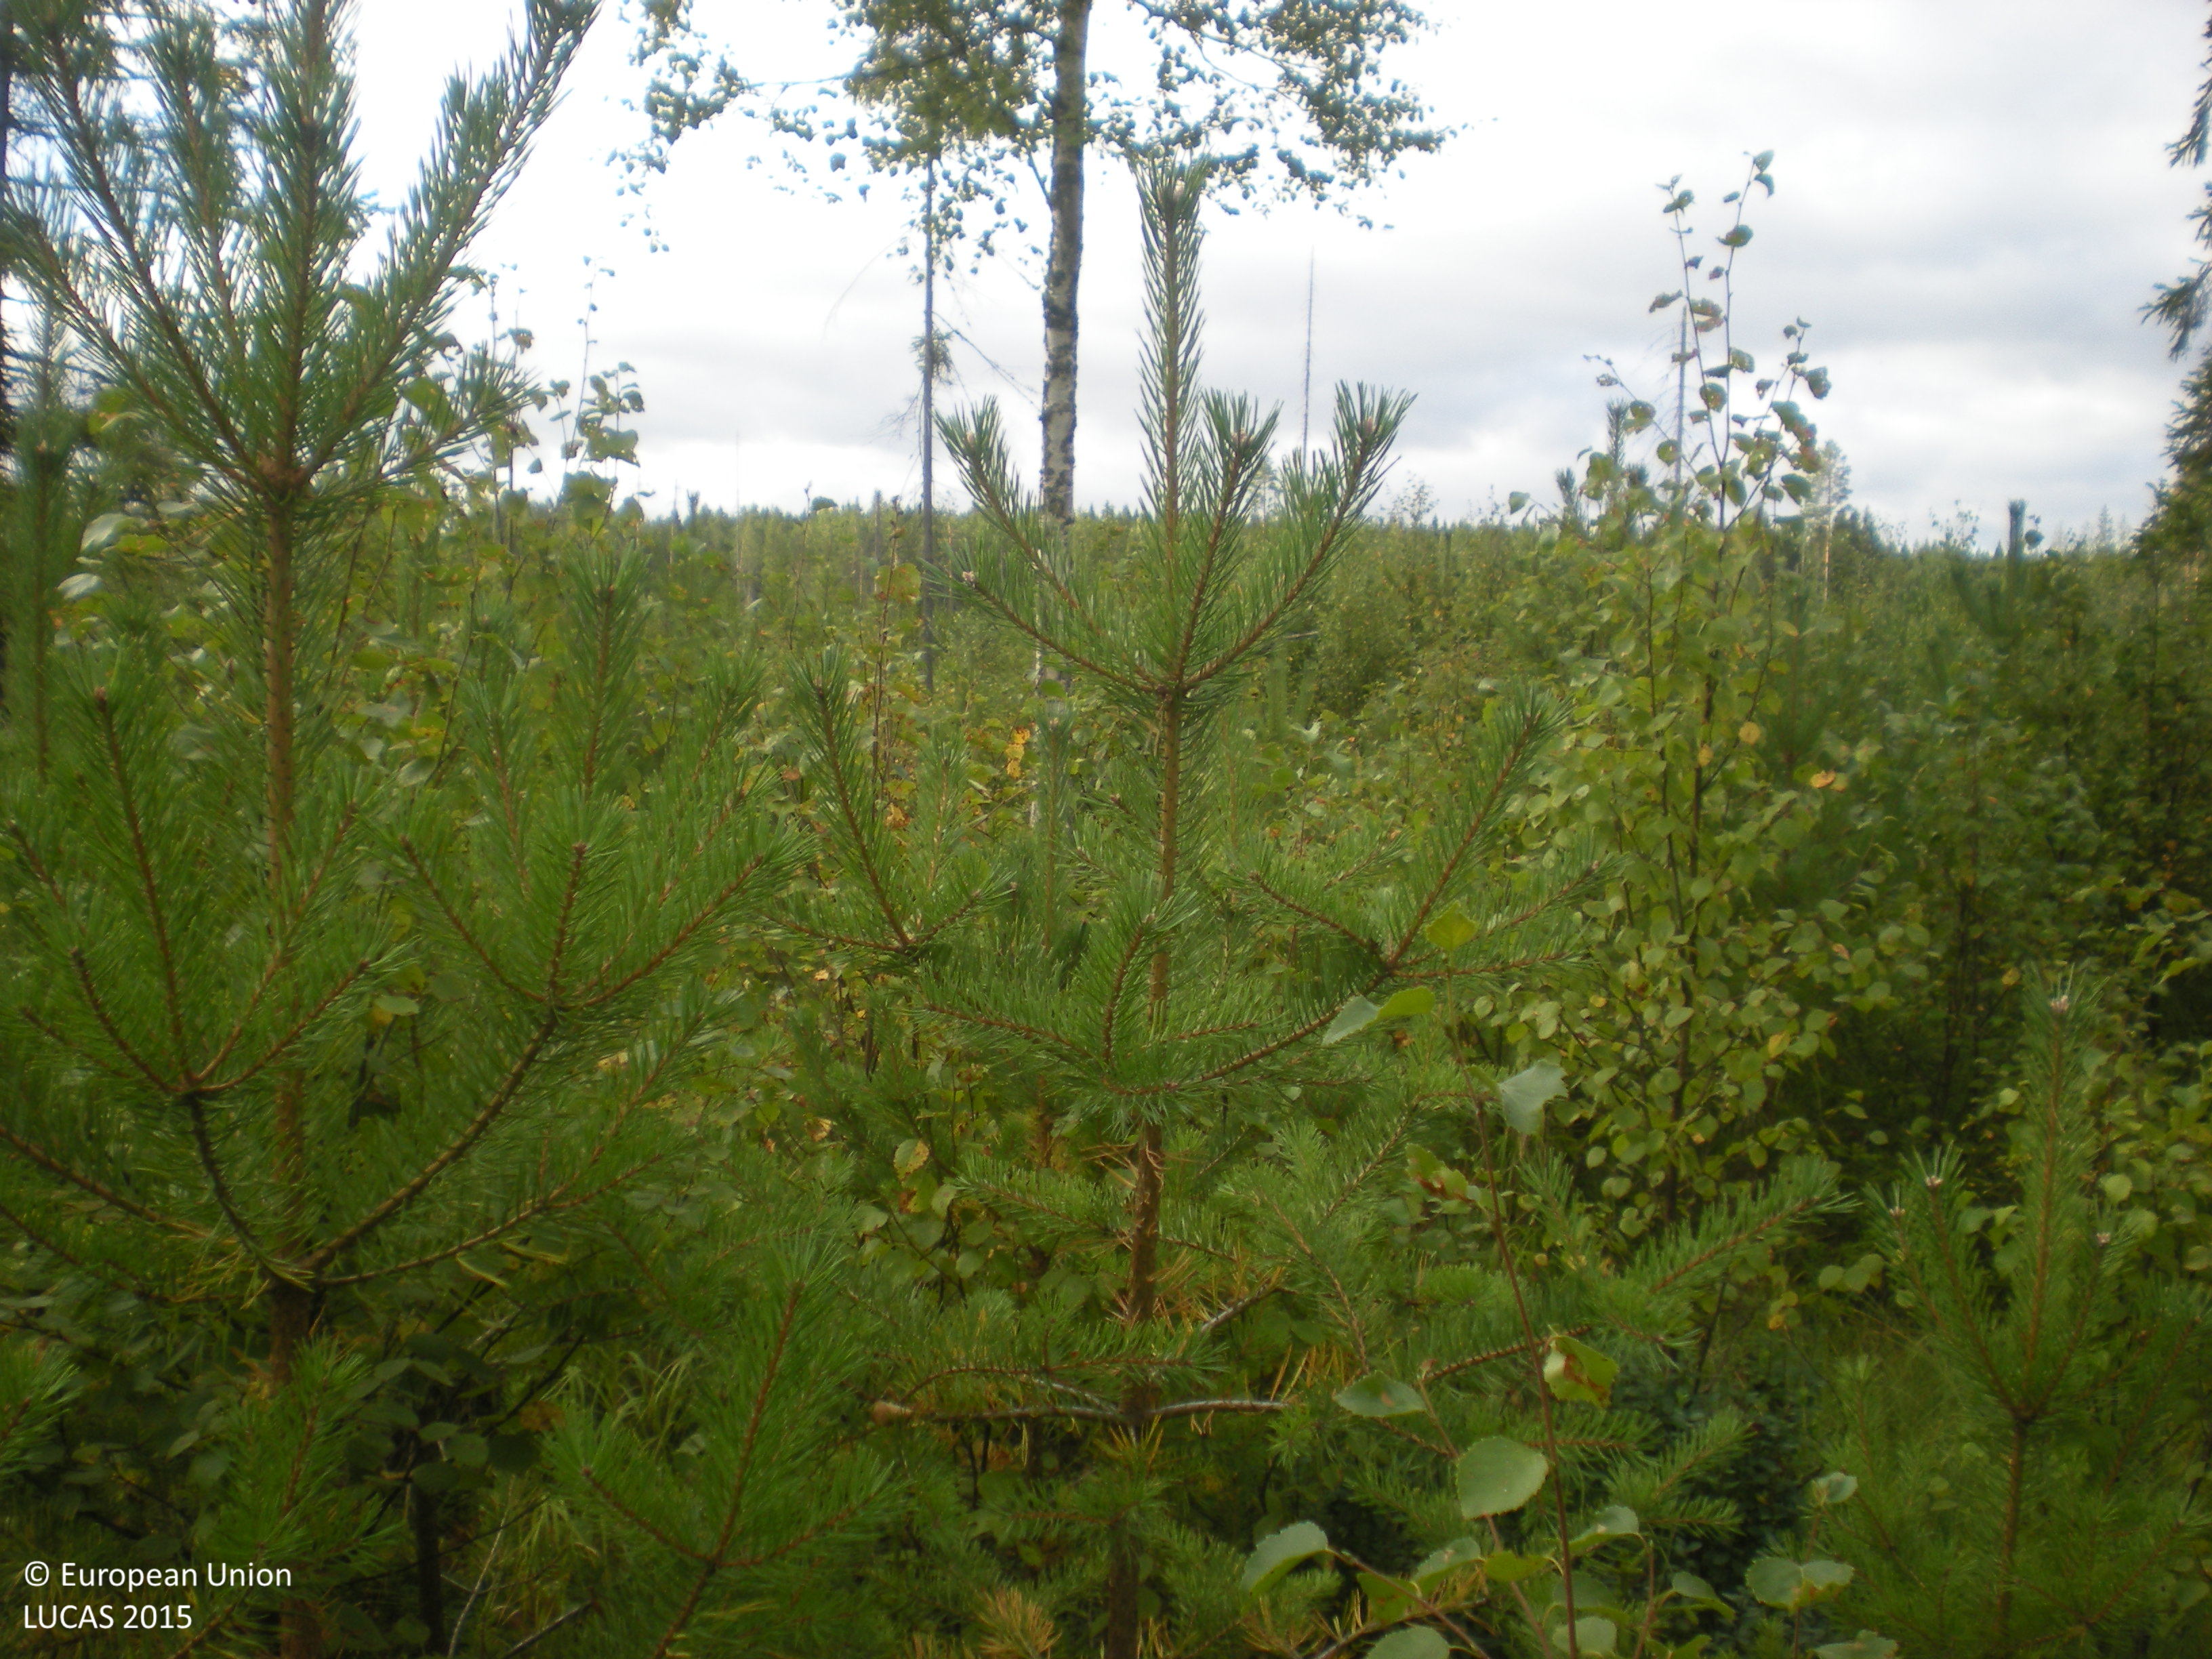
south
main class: Woodland
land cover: Pine dominated mixed woodland
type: boreal forest
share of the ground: 50 - 75 %
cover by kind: coniferous forest trees 35 %, broadleaved forest trees 35 %, herbaceous plants 20 %, shrubs 5 %, lichens and mosses 5 %
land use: Forestry
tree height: < 5 m
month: August
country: SE
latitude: 60.4681
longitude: 16.8096
